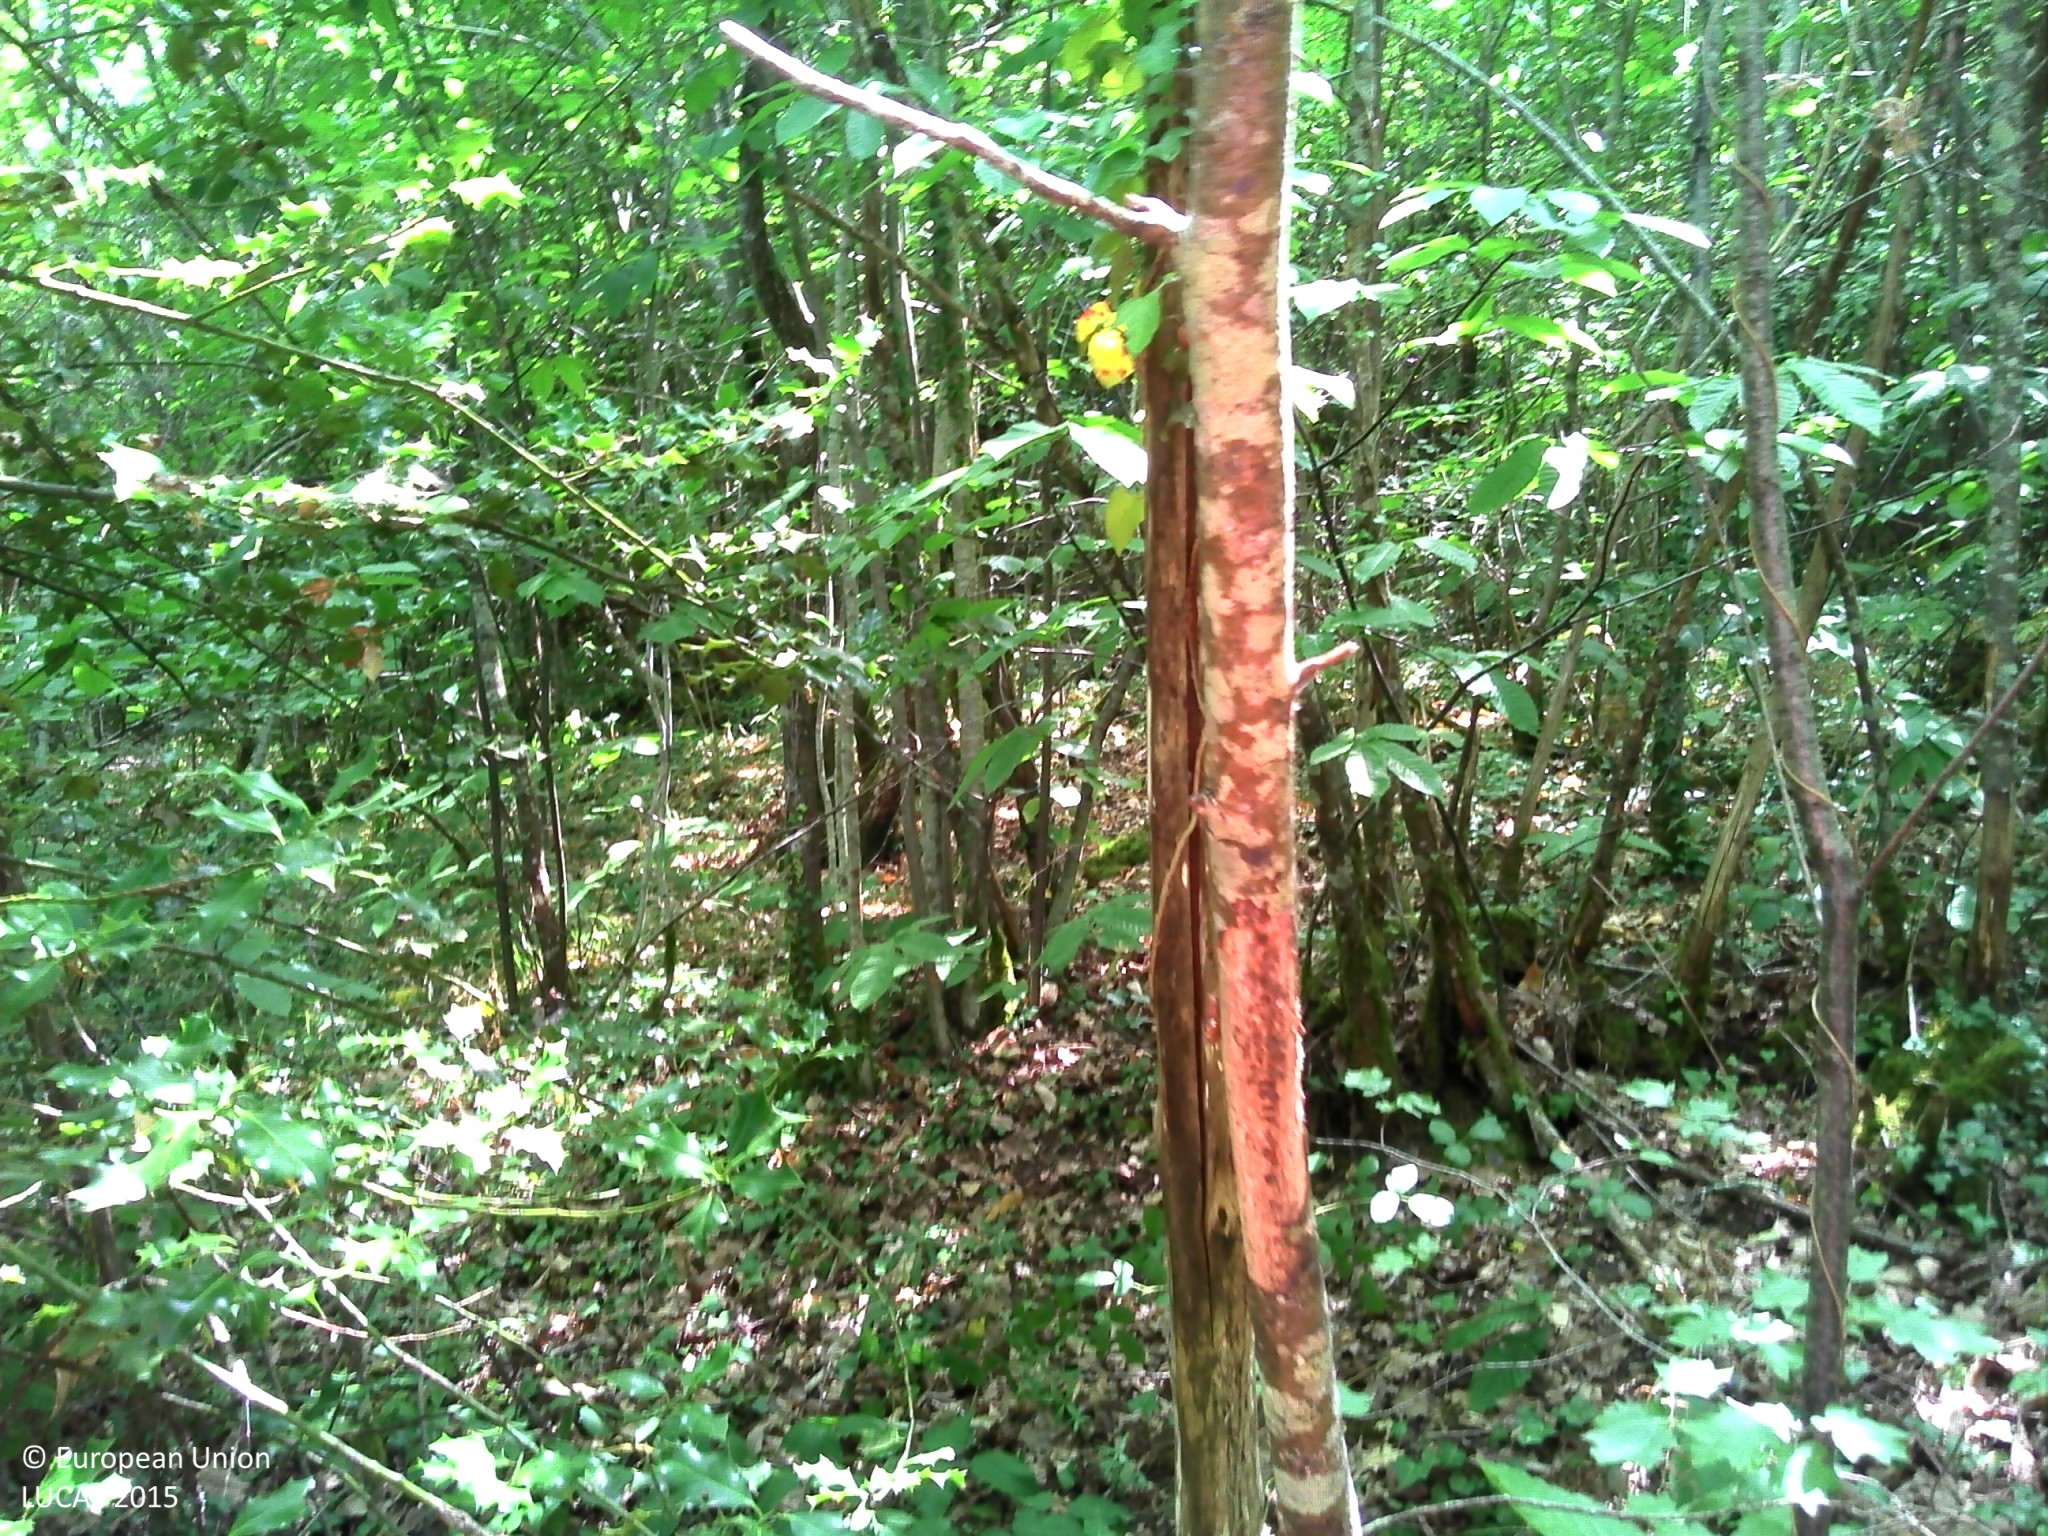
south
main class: Woodland
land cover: Broadleaved woodland
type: thermophilous deciduous forest
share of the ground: > 75 %
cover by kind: broadleaved forest trees 75 %, herbaceous plants 15 %, shrubs 10 %
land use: Forestry
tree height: > 5 m
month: July
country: FR
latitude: 45.1737
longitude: 0.7910
